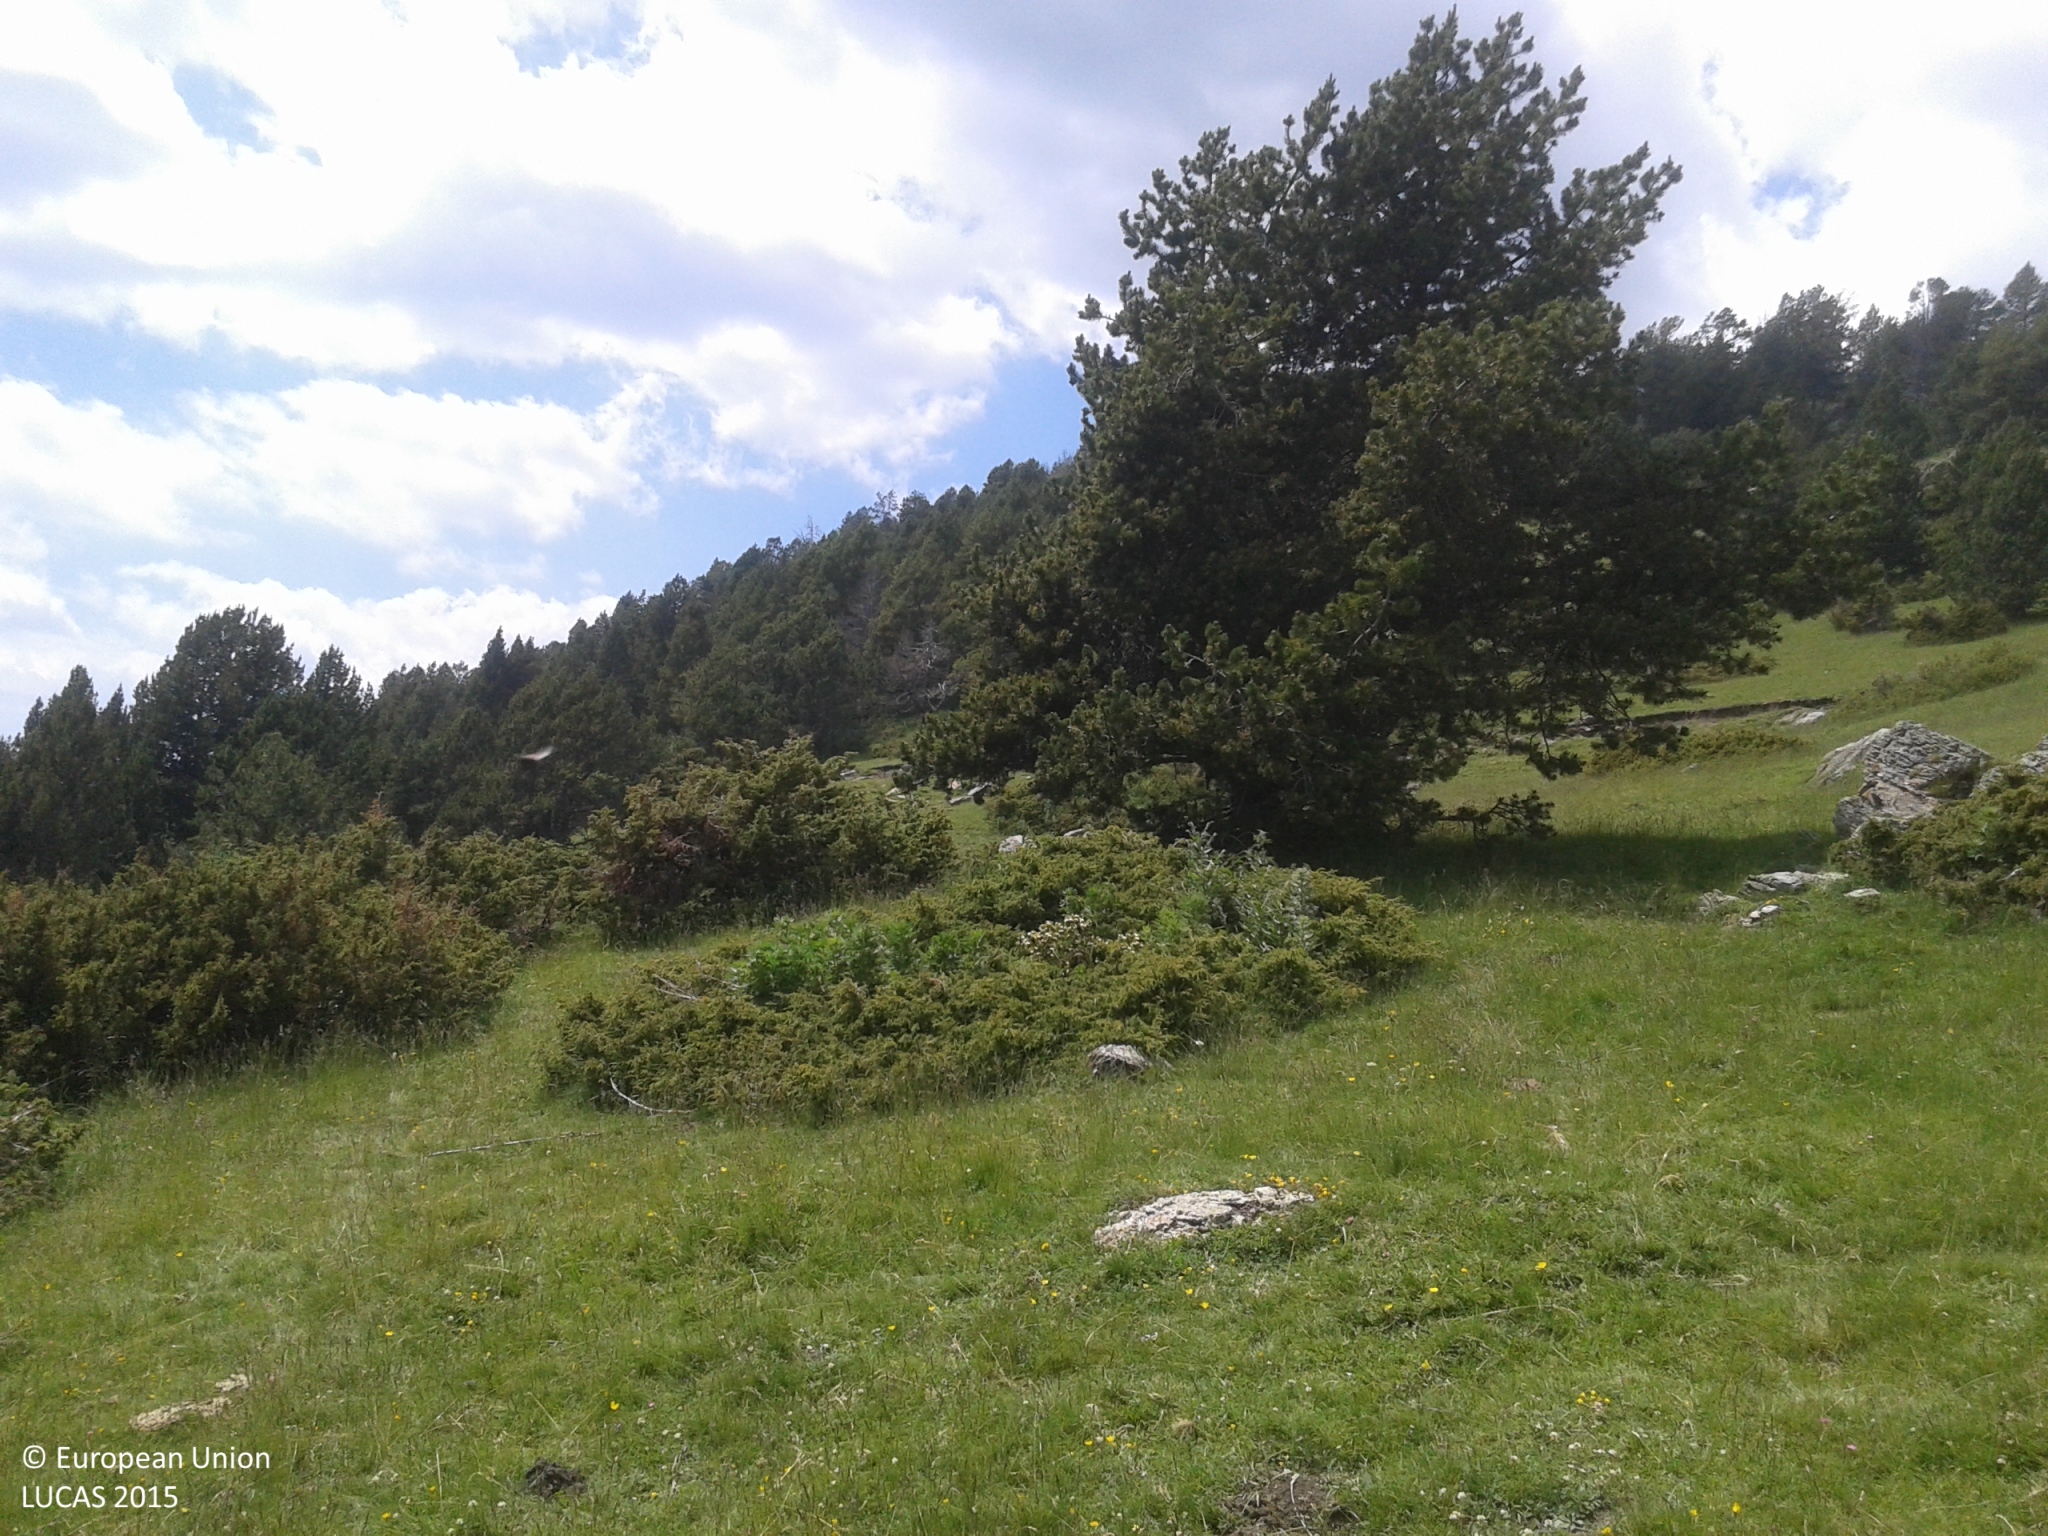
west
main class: Shrubland
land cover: Shrubland with sparse tree cover
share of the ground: > 75 %
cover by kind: herbaceous plants 85 %, shrubs 10 %, coniferous forest trees 5 %
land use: Agriculture (excluding fallow land and kitchen gardens)
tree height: > 5 m
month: June
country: ES
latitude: 42.4126
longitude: 1.5891
